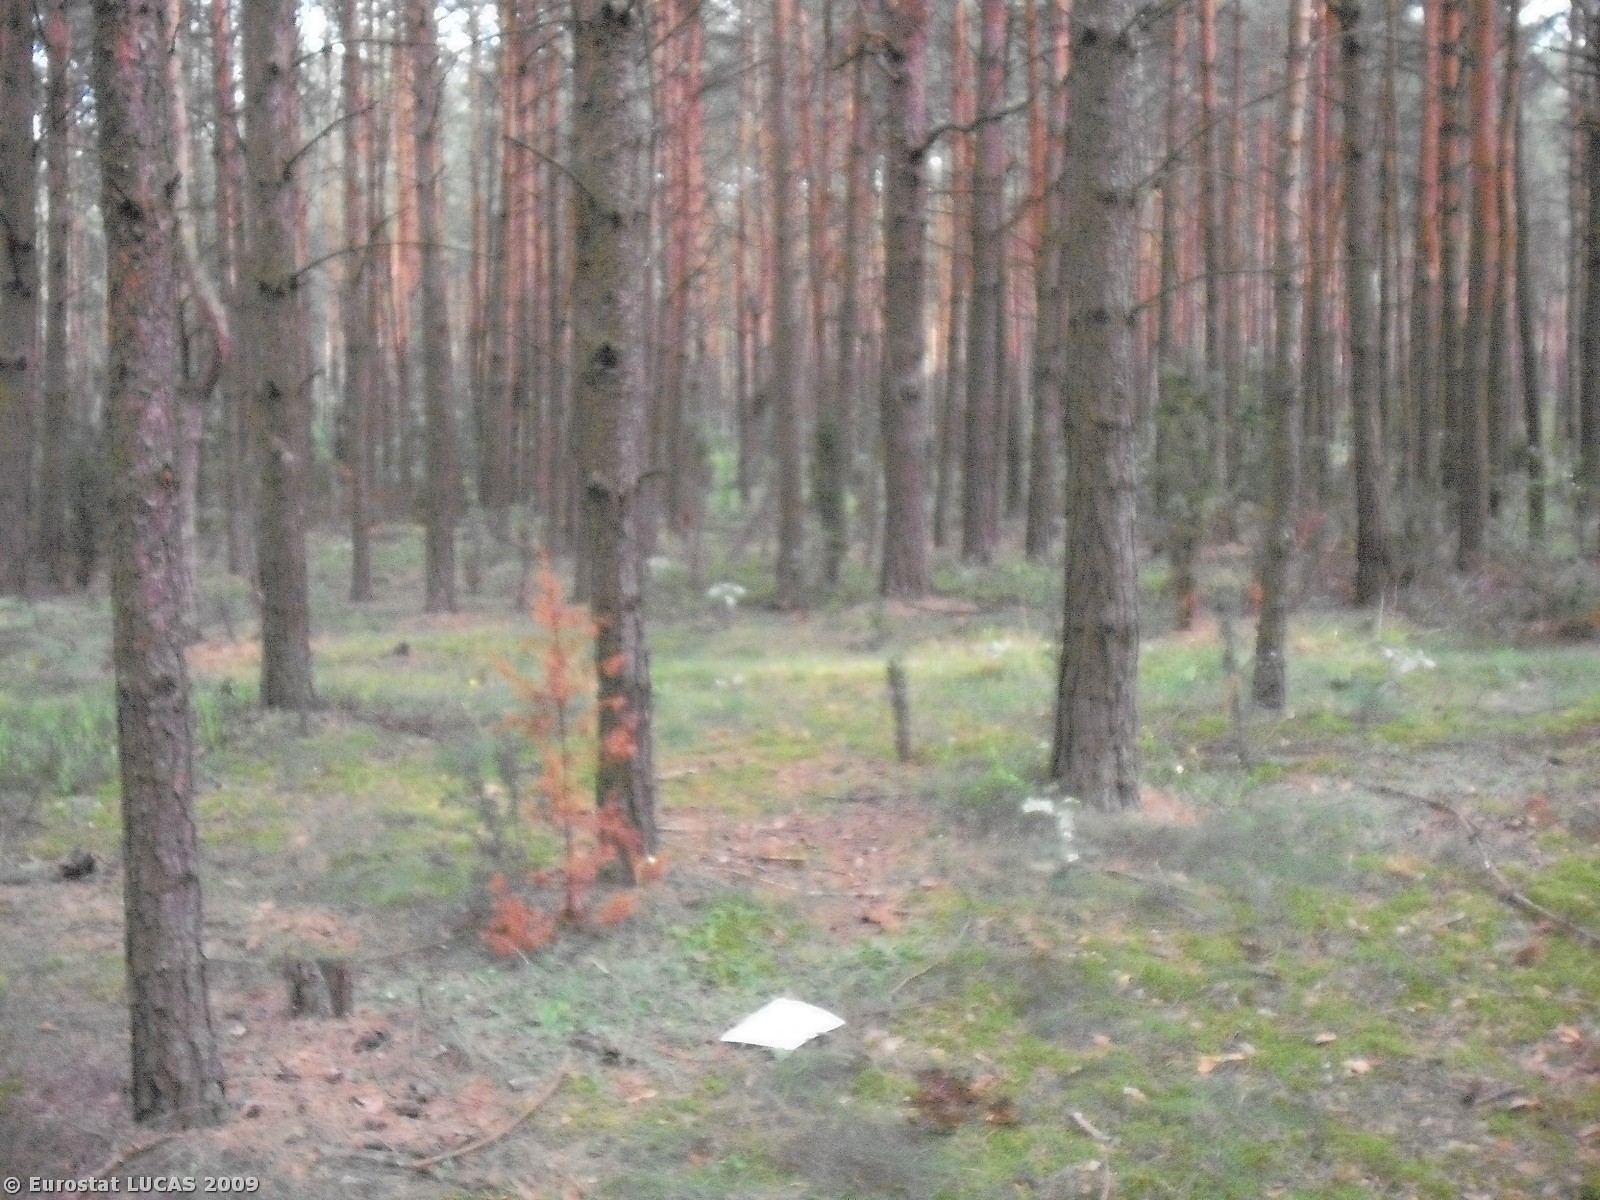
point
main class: Woodland
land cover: Coniferous woodland
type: hemiboreal forest and nemoral coniferous forest and mixed broadleaved-coniferous forest
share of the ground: > 75 %
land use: Forestry
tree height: > 5 m
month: July
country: PL
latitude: 51.2646
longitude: 21.3859
